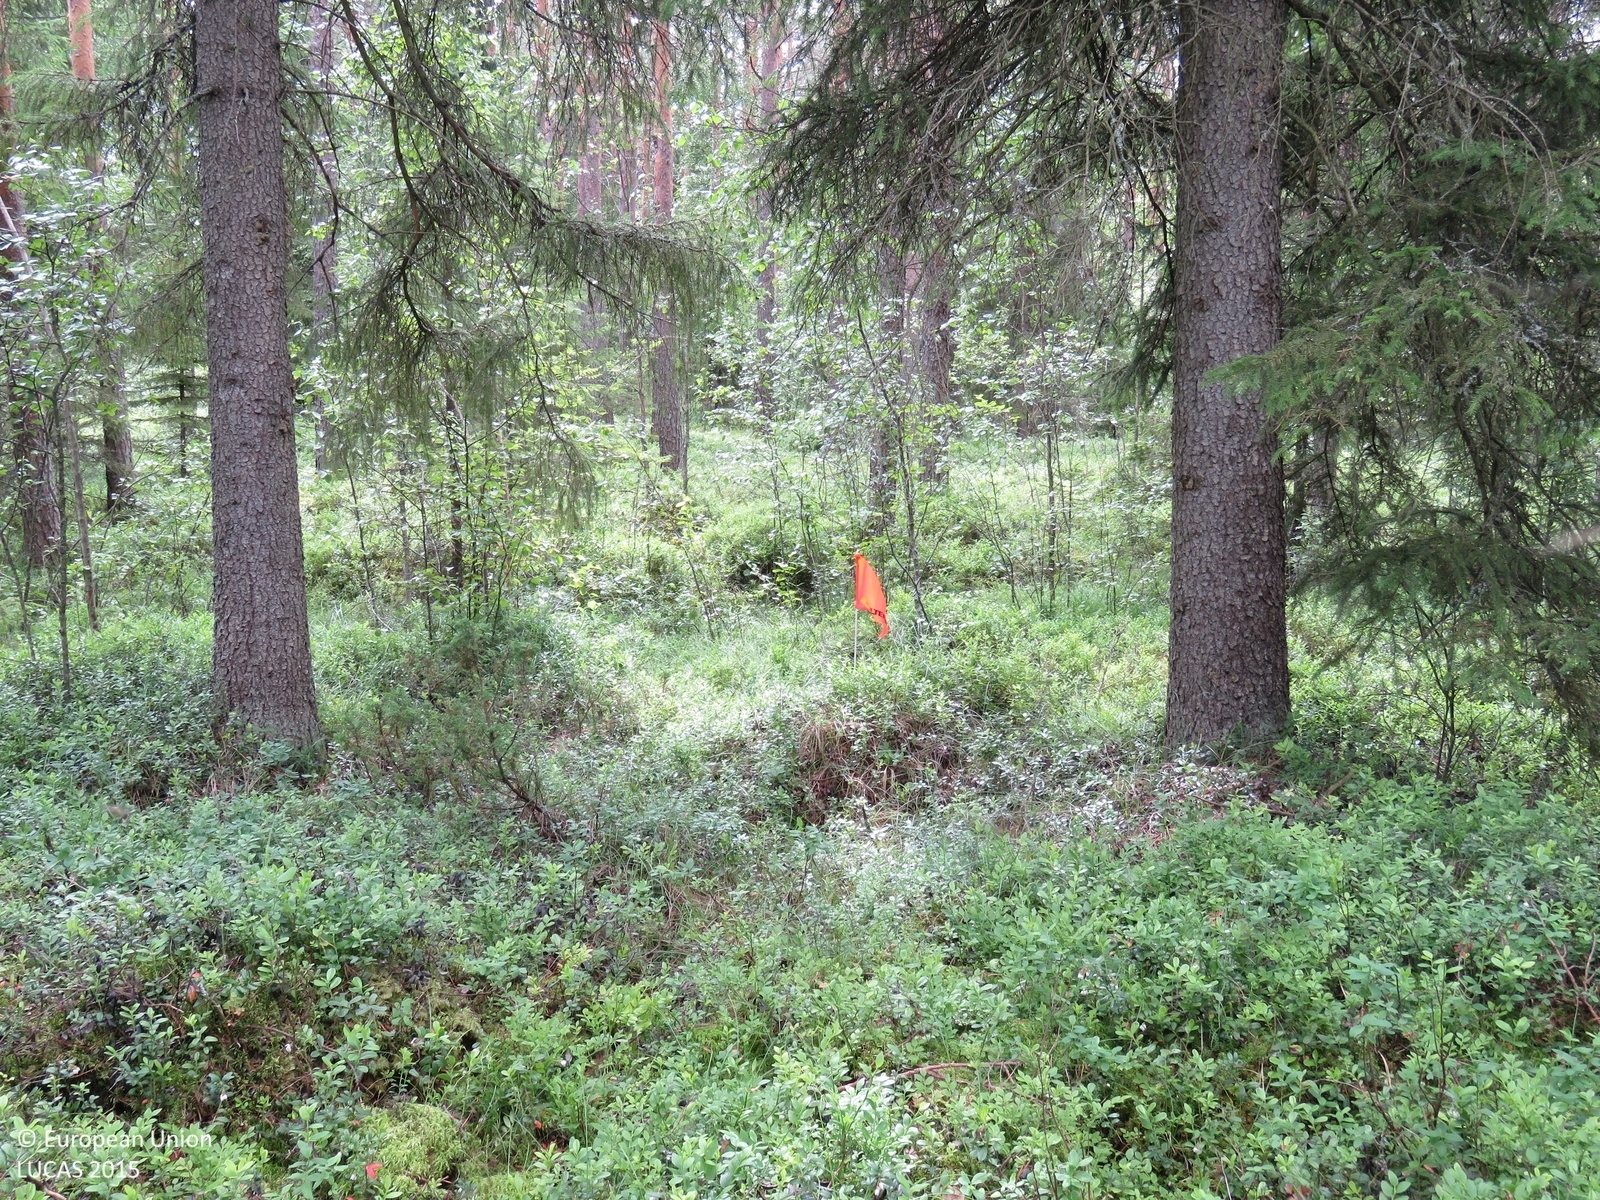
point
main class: Woodland
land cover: Spruce dominated coniferous woodland
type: boreal forest
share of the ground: > 75 %
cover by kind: coniferous forest trees 75 %, shrubs 15 %, broadleaved forest trees 10 %
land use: Forestry
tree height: > 5 m
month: July
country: FI
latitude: 64.4686
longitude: 26.5225
